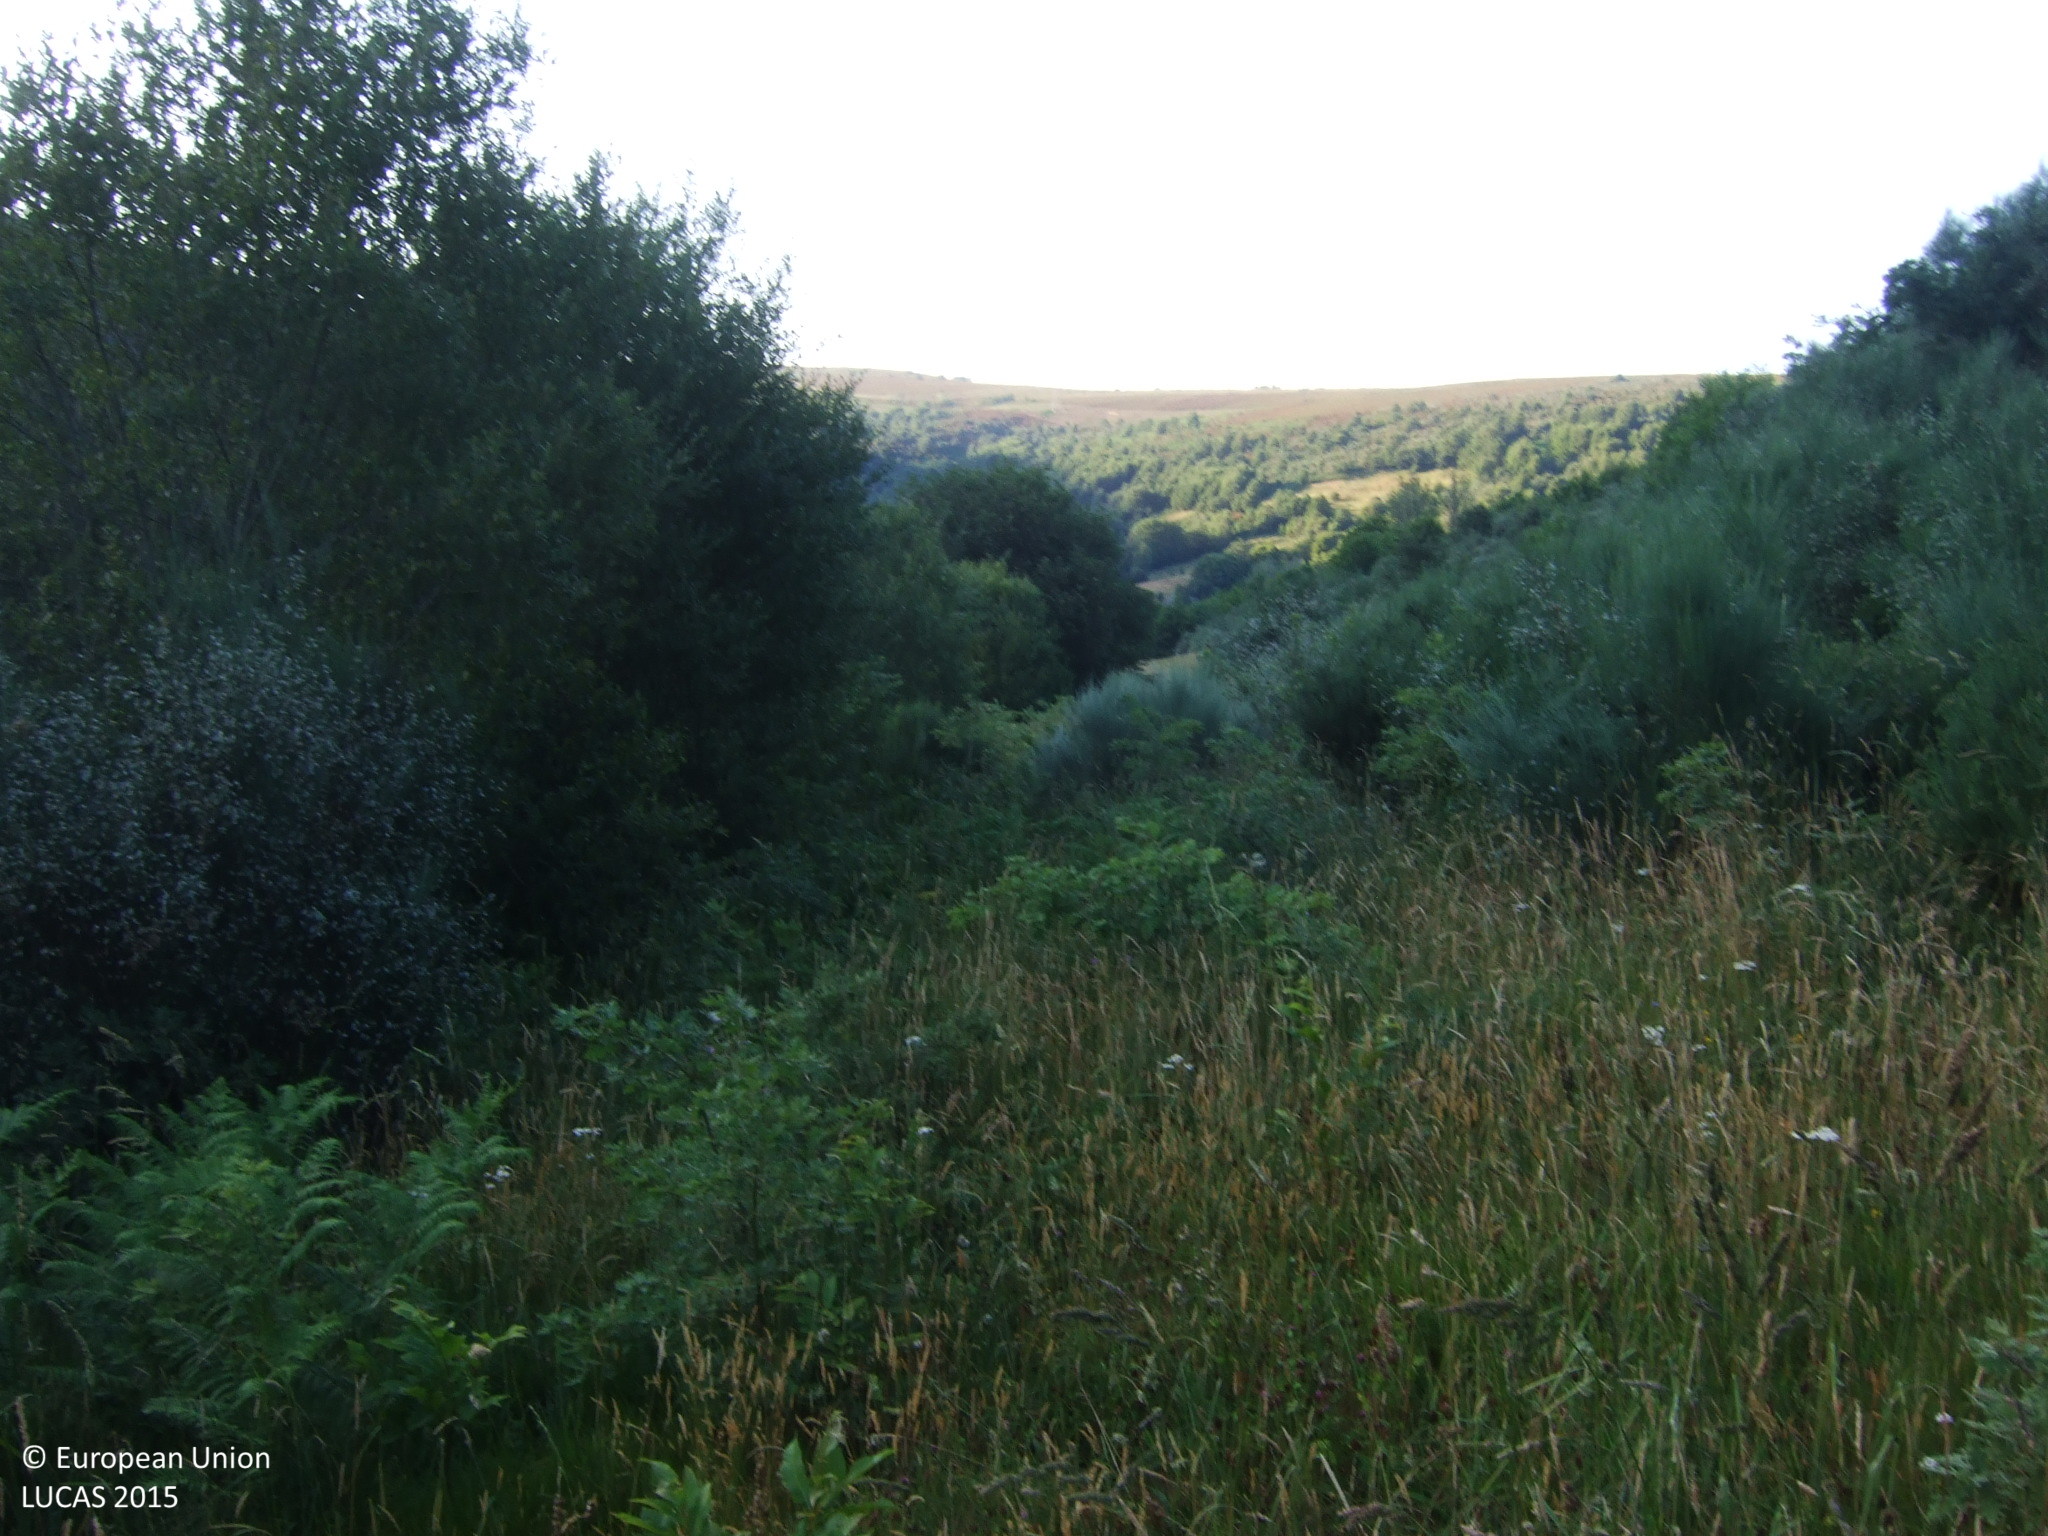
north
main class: Grassland
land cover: Grassland with sparse tree/shrub cover
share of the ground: > 75 %
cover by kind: herbaceous plants 90 %, broadleaved forest trees 5 %, shrubs 5 %
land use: Abandoned areas
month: June
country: ES
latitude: 42.7018
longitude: -6.9655
